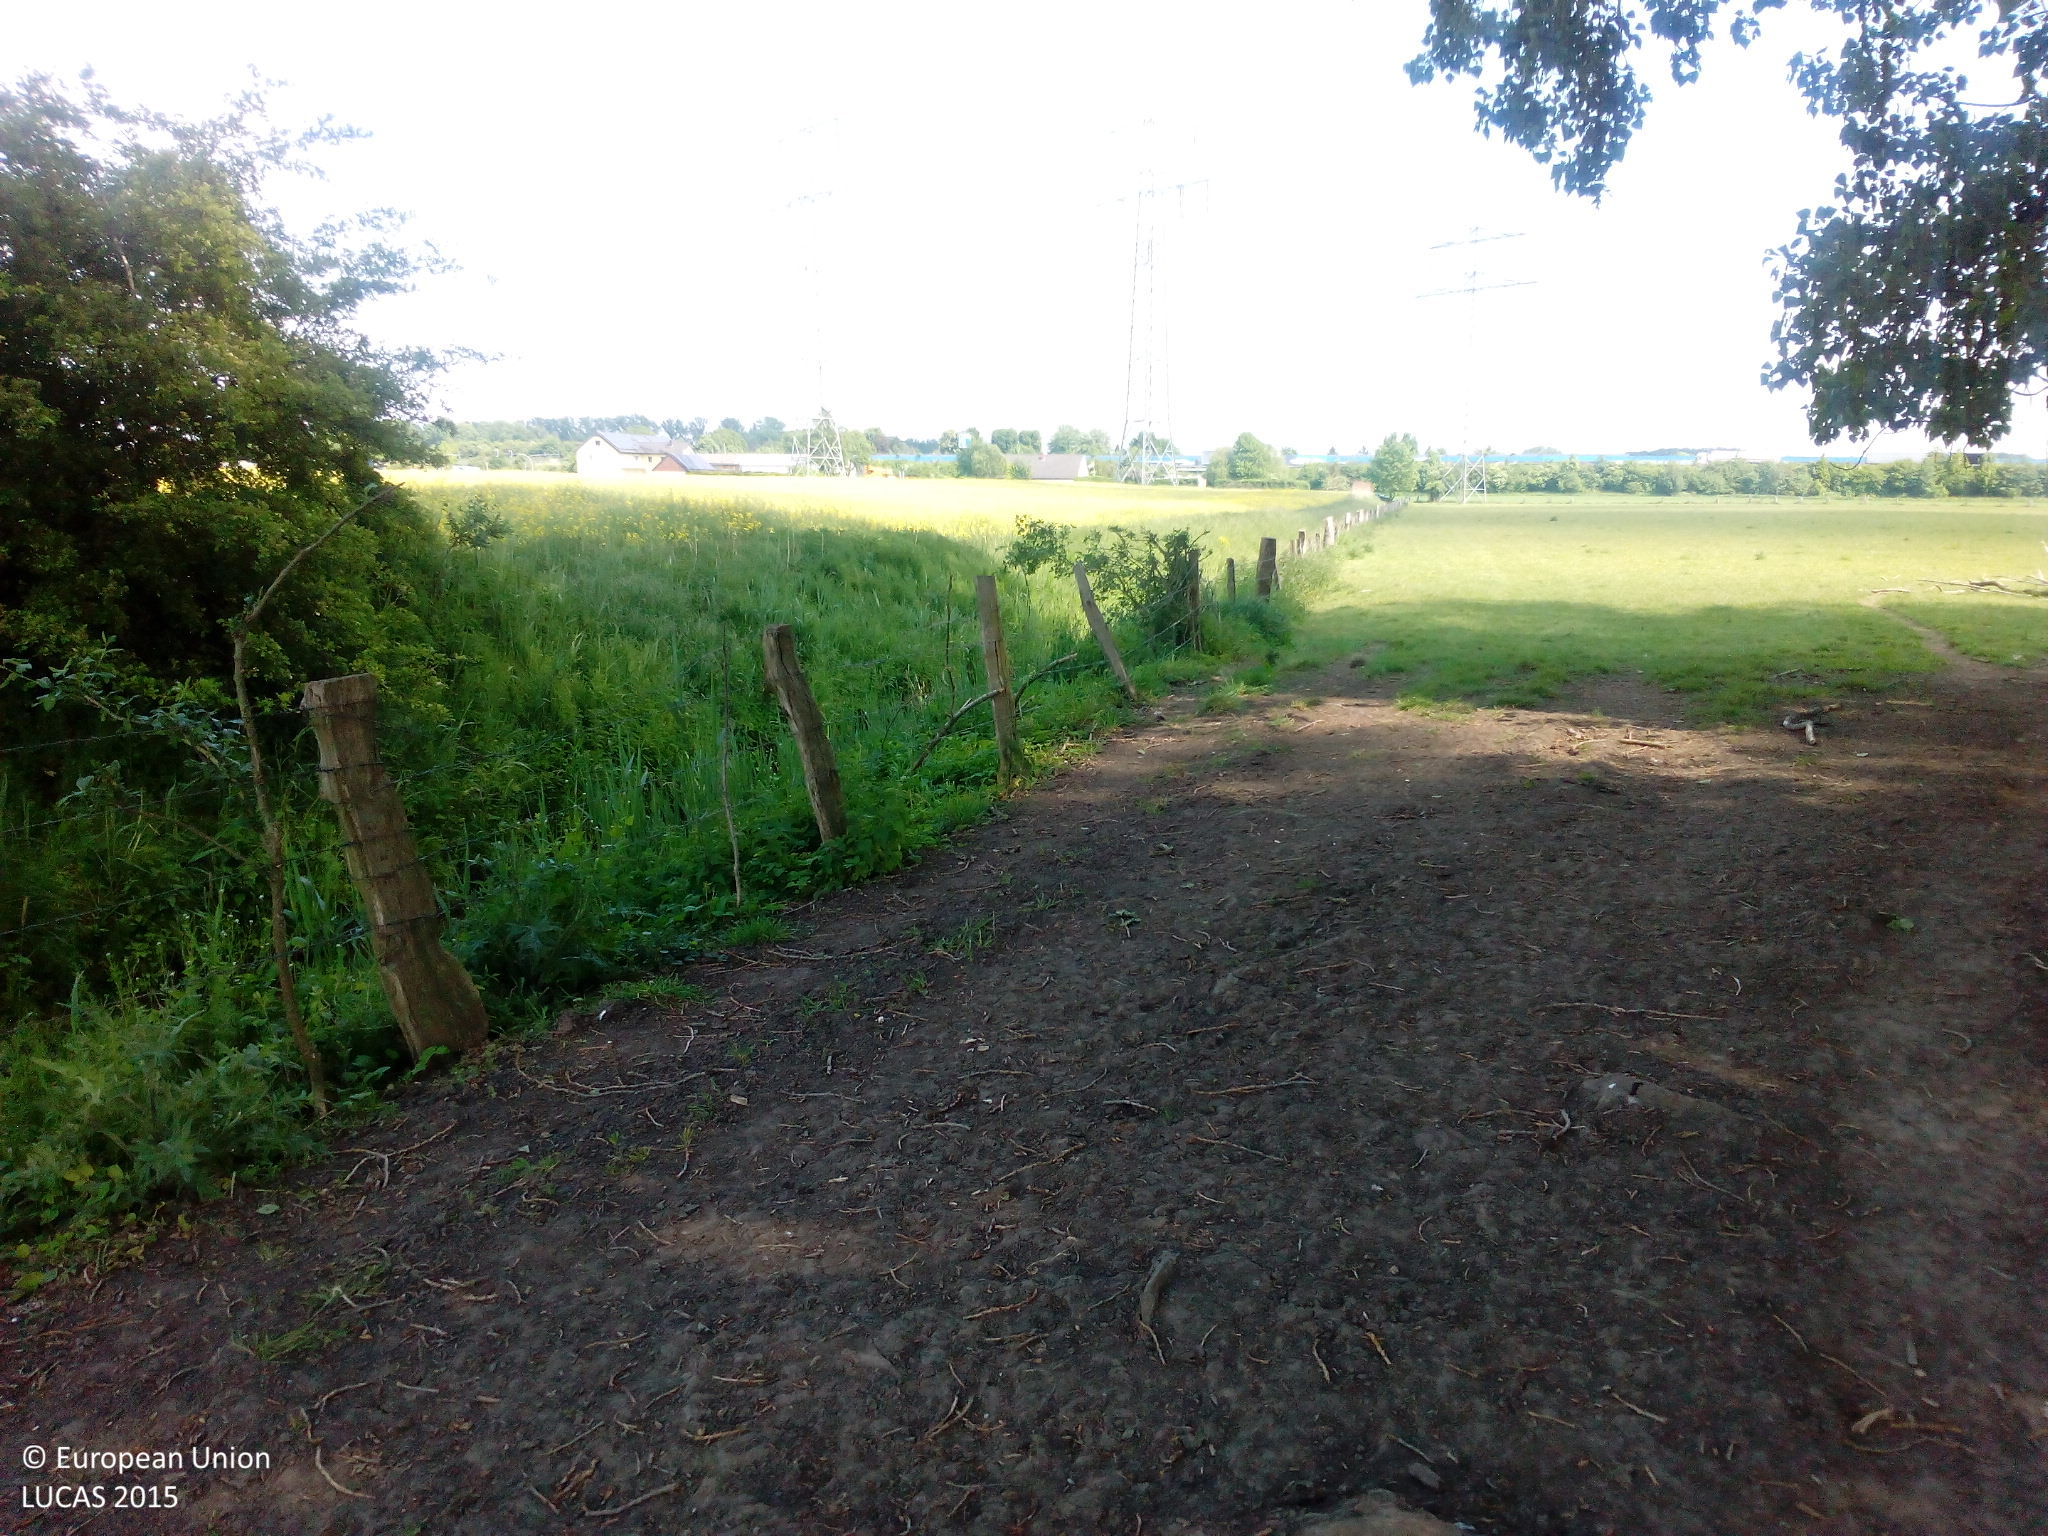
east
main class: Grassland
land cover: Grassland without tree/shrub cover
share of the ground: > 75 %
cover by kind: herbaceous plants 100 %
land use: Agriculture (excluding fallow land and kitchen gardens)
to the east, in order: Grassland without tree/shrub cover; Fences; Broadleaved woodland; Ditches and canals; Fences; Broadleaved woodland; Other bare soil; Fences; Grass margins; Ditches and canals; Grassland without tree/shrub cover; Rape and turnip rape
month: May
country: DE
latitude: 51.6947
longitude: 7.9605
